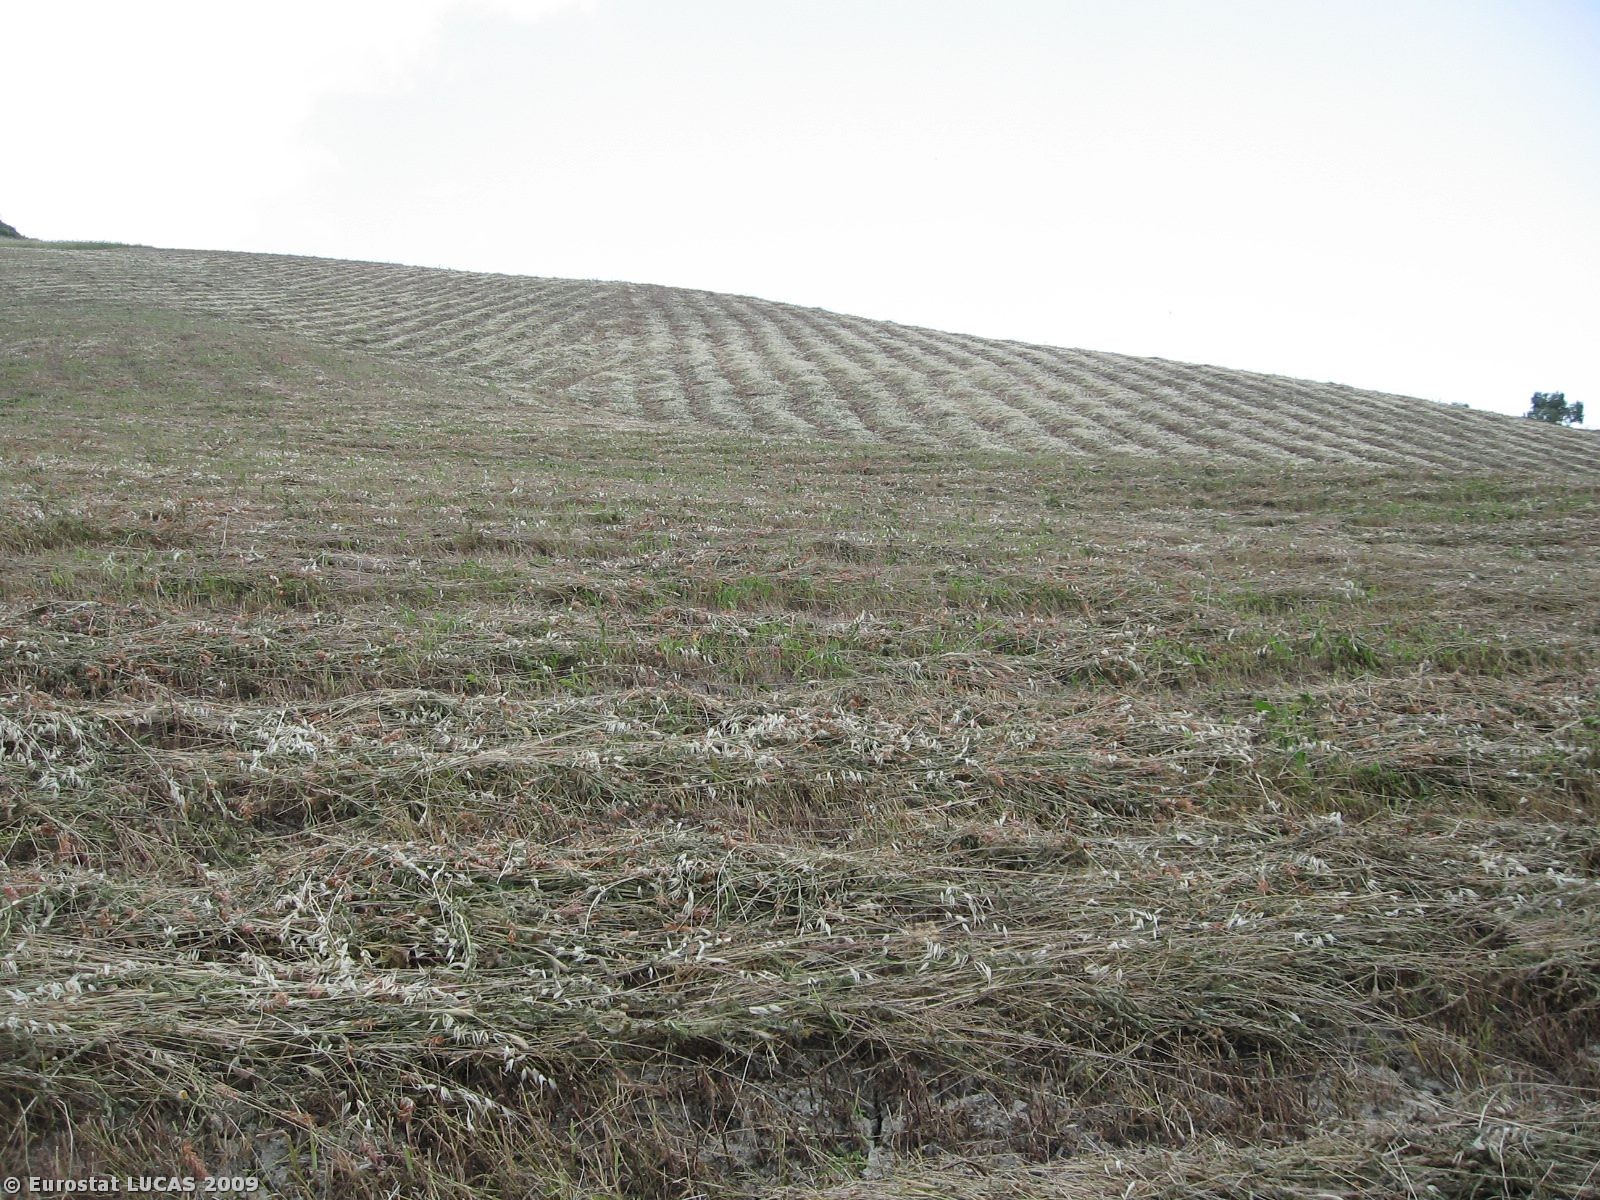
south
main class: Cropland
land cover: Temporary grasslands
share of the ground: > 75 %
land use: Agriculture (excluding fallow land and kitchen gardens)
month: May
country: IT
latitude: 39.0128
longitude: 16.8147
